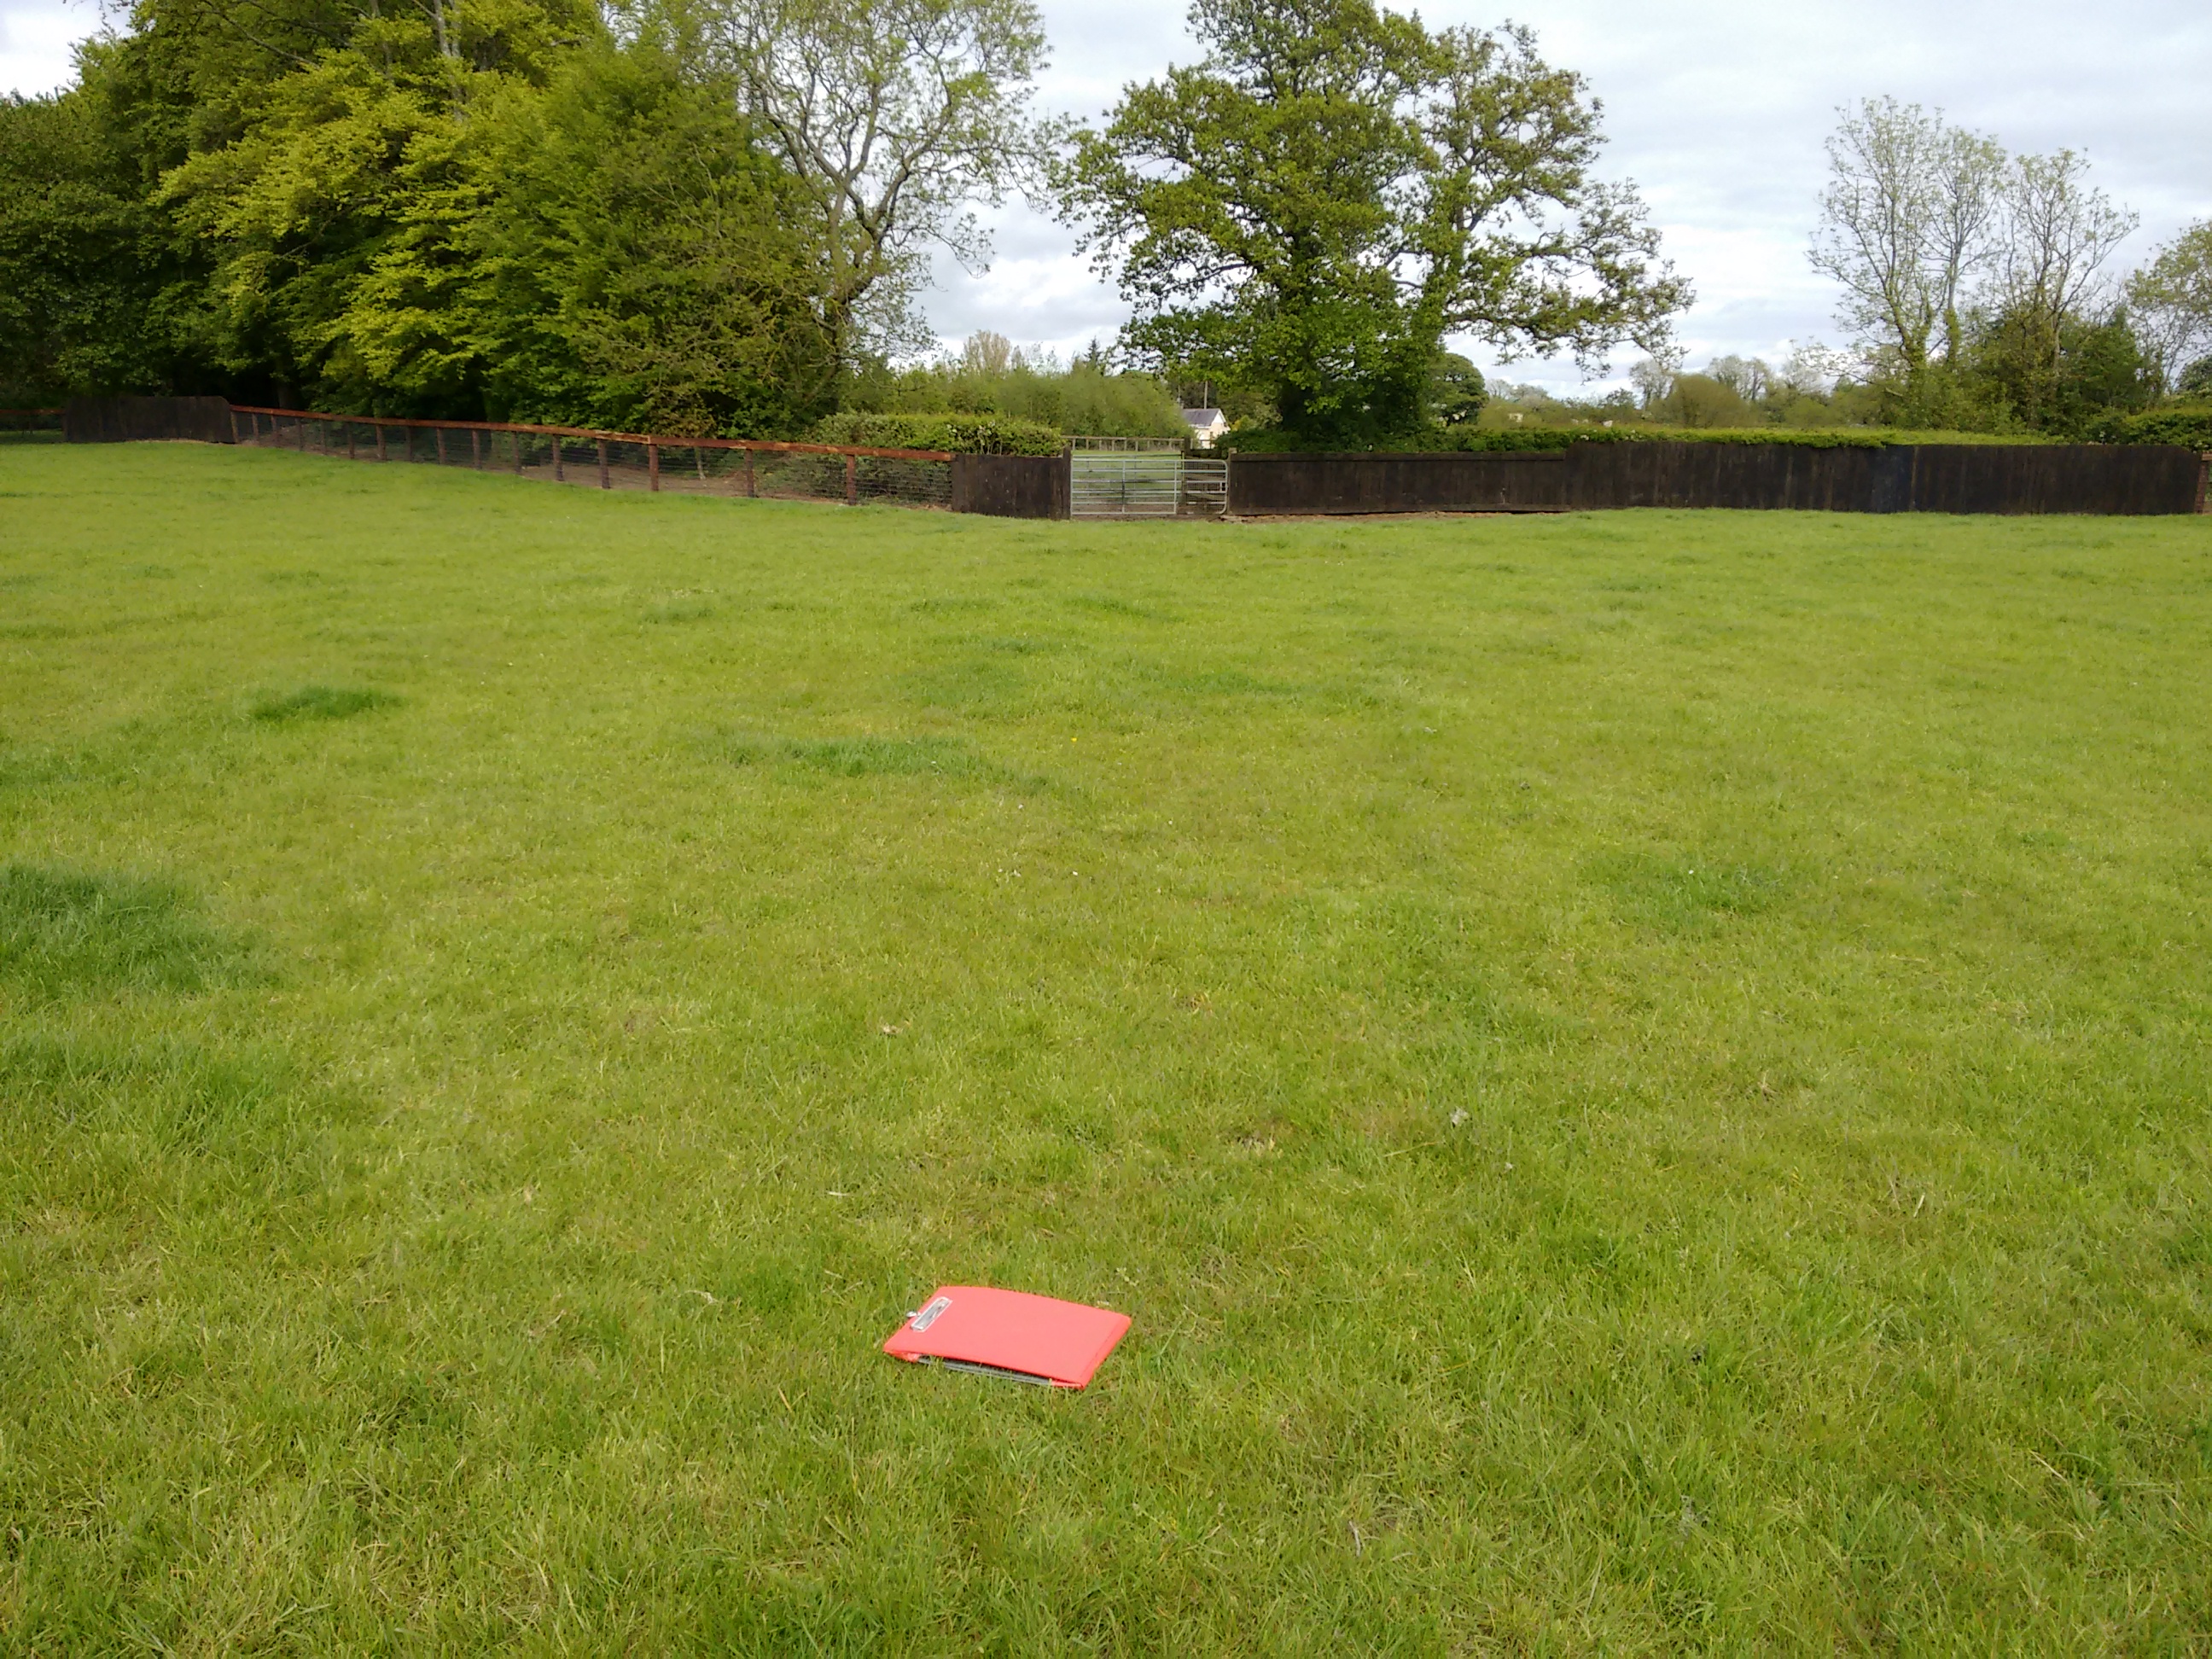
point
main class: Grassland
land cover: Grassland without tree/shrub cover
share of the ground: > 75 %
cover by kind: herbaceous plants 95 %, unconsolidated bare surface 5 %
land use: Agriculture (excluding fallow land and kitchen gardens)
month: May
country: IE
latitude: 53.4251
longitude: -6.7016
